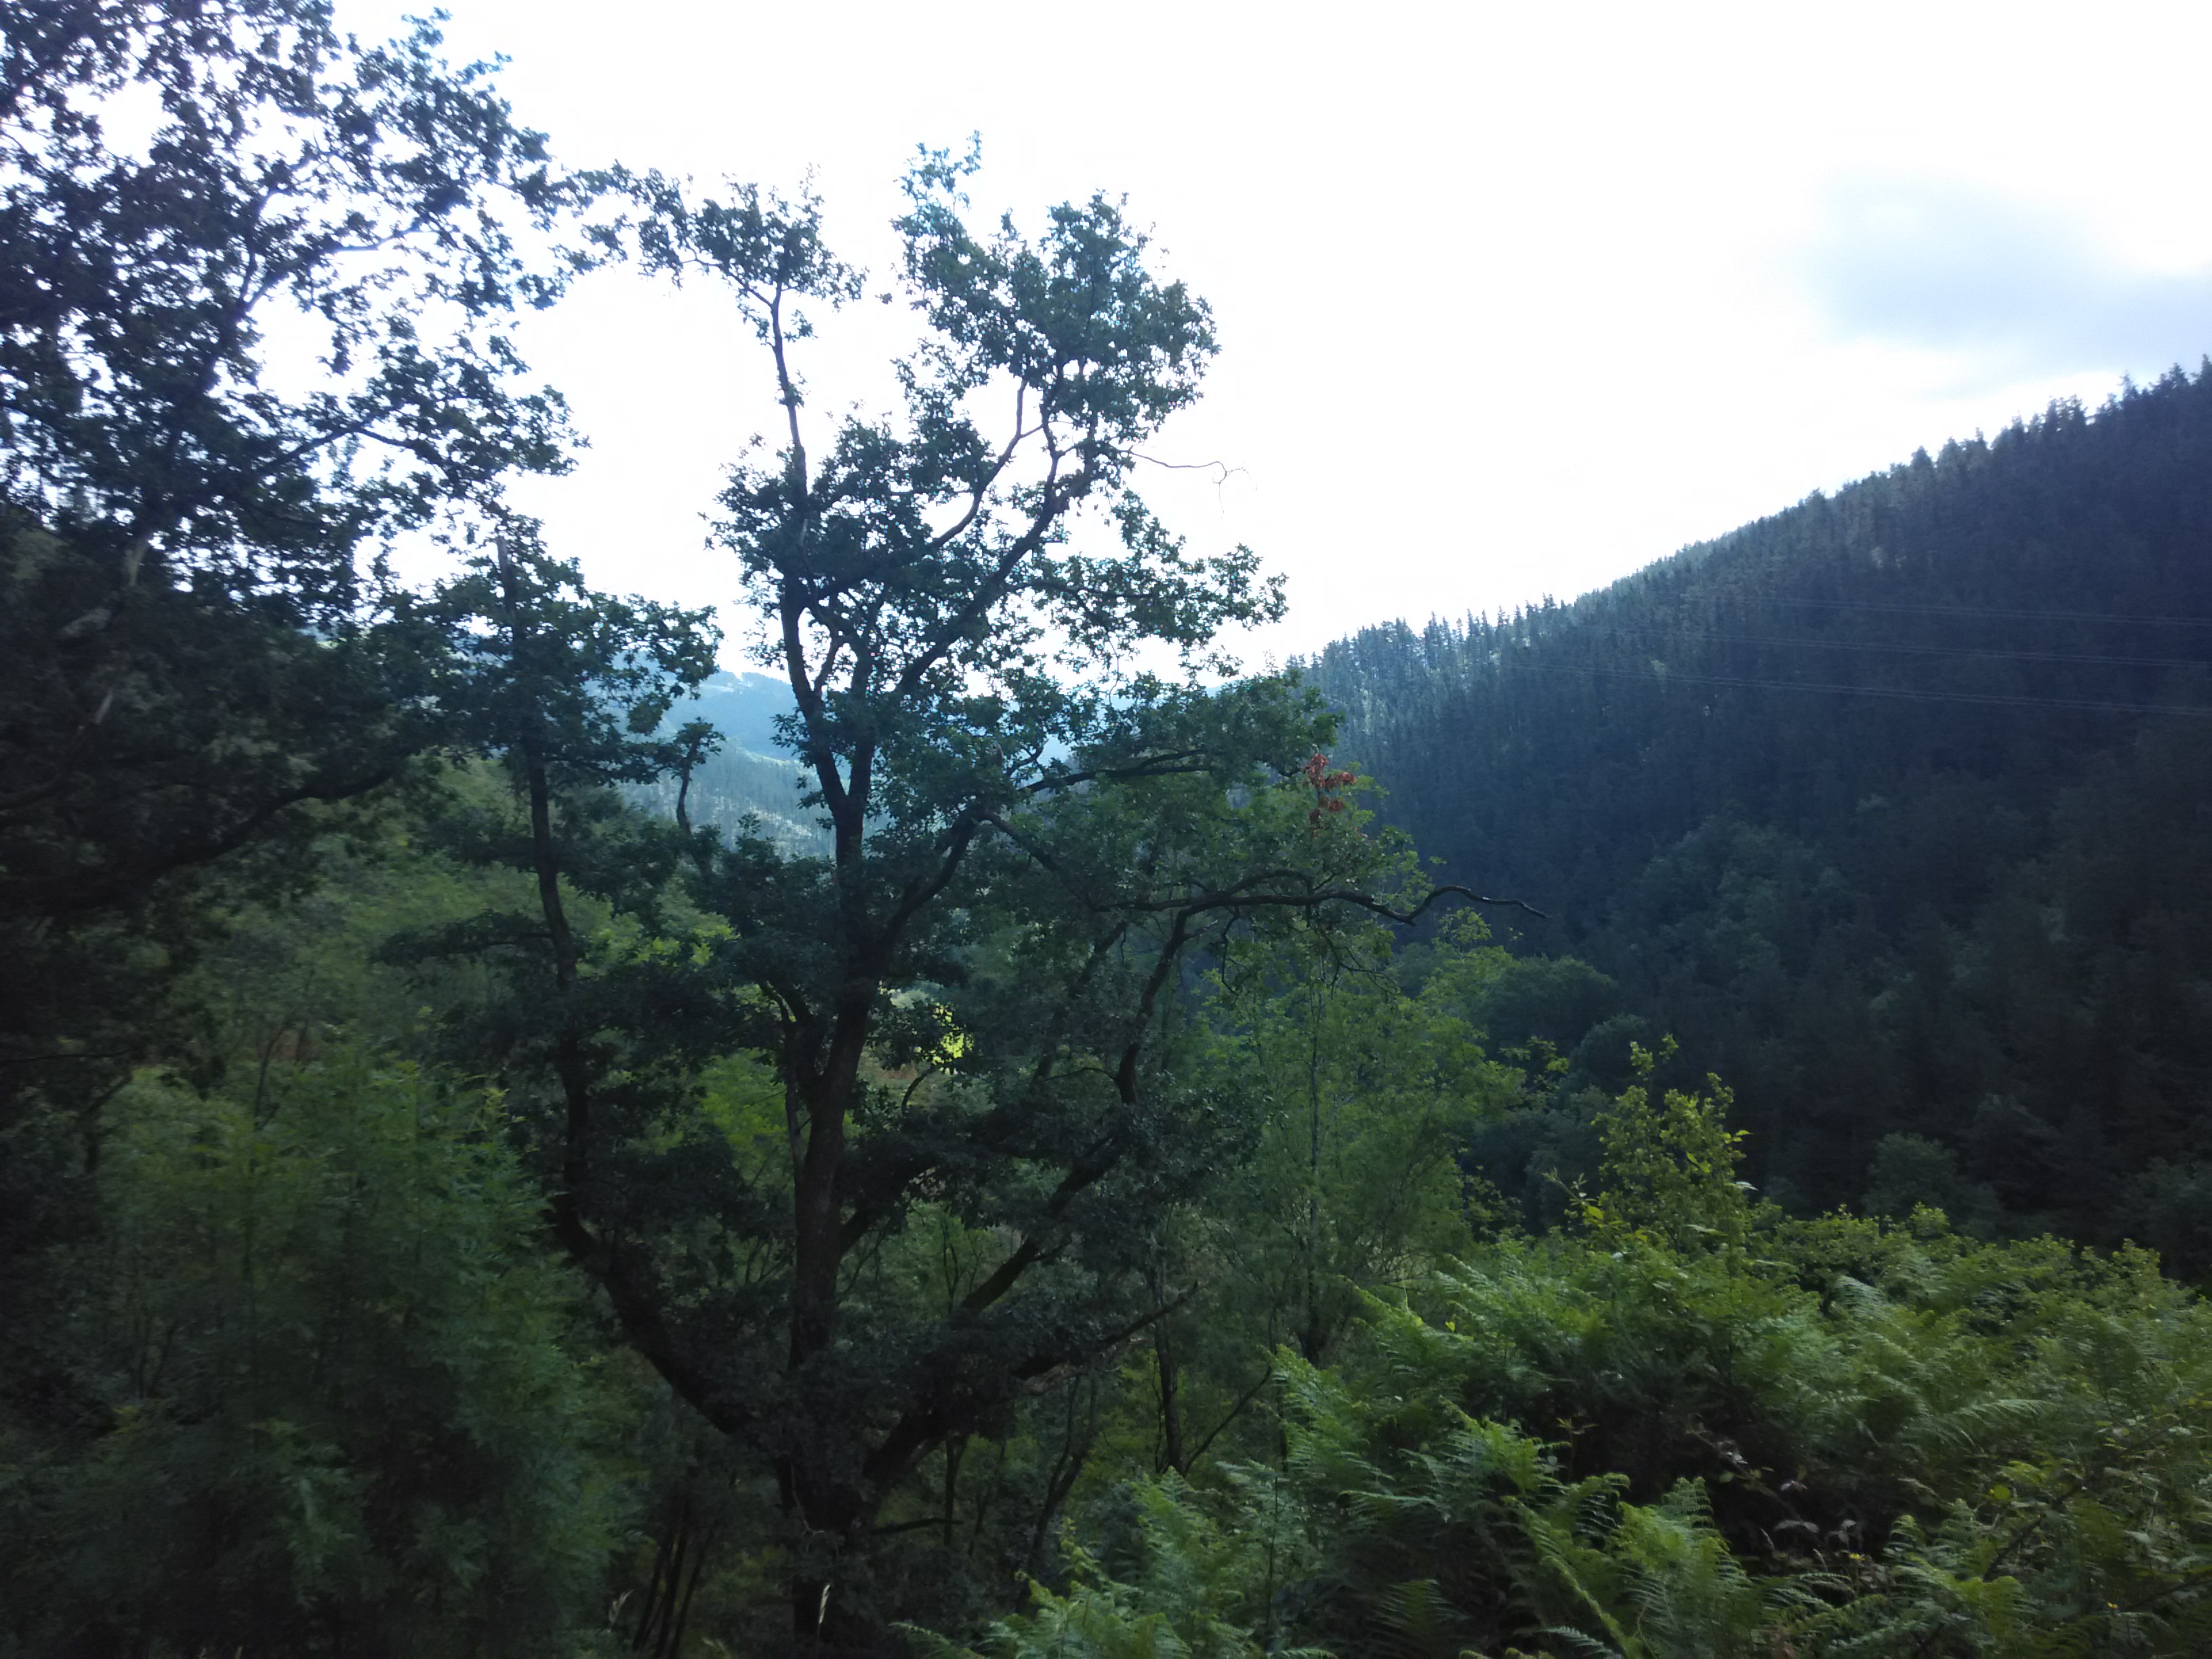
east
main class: Grassland
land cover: Grassland without tree/shrub cover
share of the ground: > 75 %
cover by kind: herbaceous plants 100 %
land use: Agriculture (excluding fallow land and kitchen gardens)
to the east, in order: Grassland without tree/shrub cover; Electric lines; Shruby margins; Fences; Single bushes/trees; Broadleaved woodland; Shrubland without tree cover; Pine dominated coniferous woodland; Tracks; Shrubland without tree cover; Pine dominated coniferous woodland; Electric lines
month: June
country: ES
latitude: 43.2208
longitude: -2.2496
